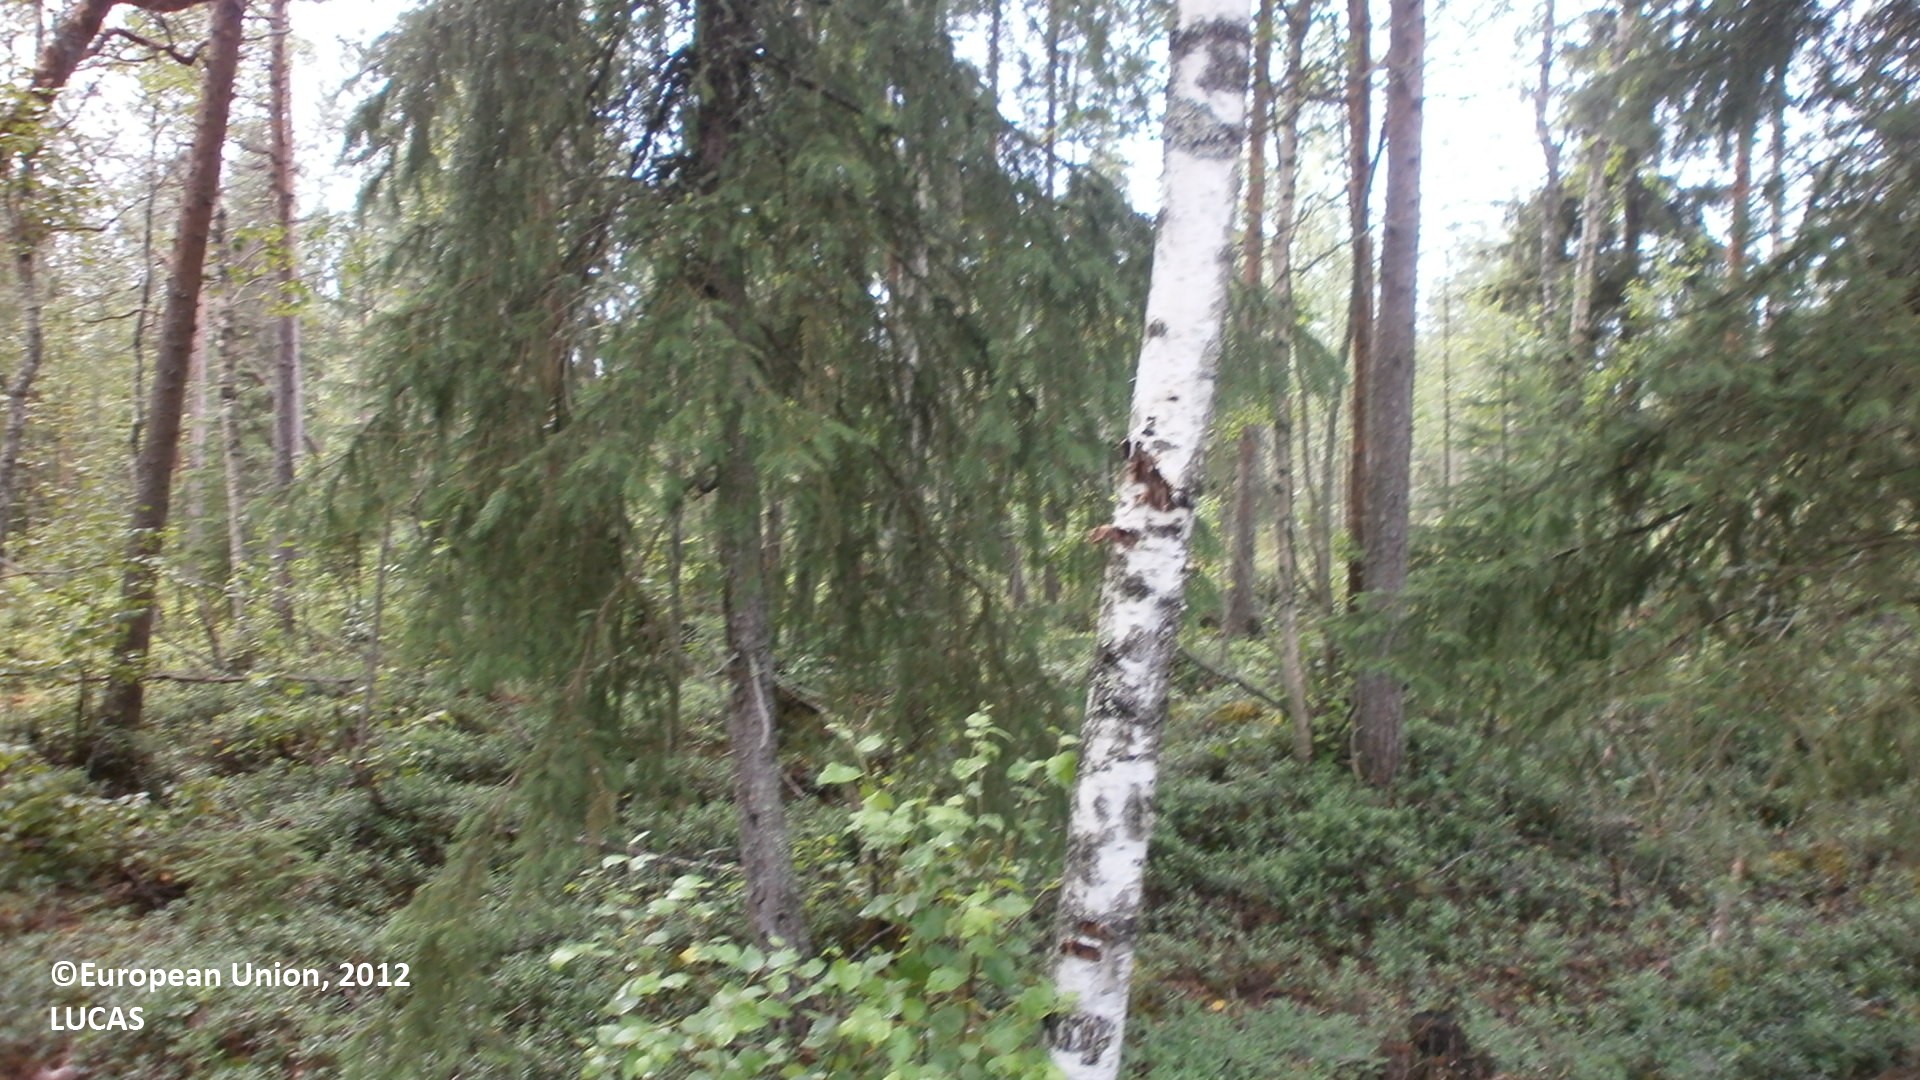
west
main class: Woodland
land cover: Pine dominated mixed woodland
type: boreal forest
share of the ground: 50 - 75 %
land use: Forestry
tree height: > 5 m
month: July
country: FI
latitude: 64.1086
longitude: 23.7505
